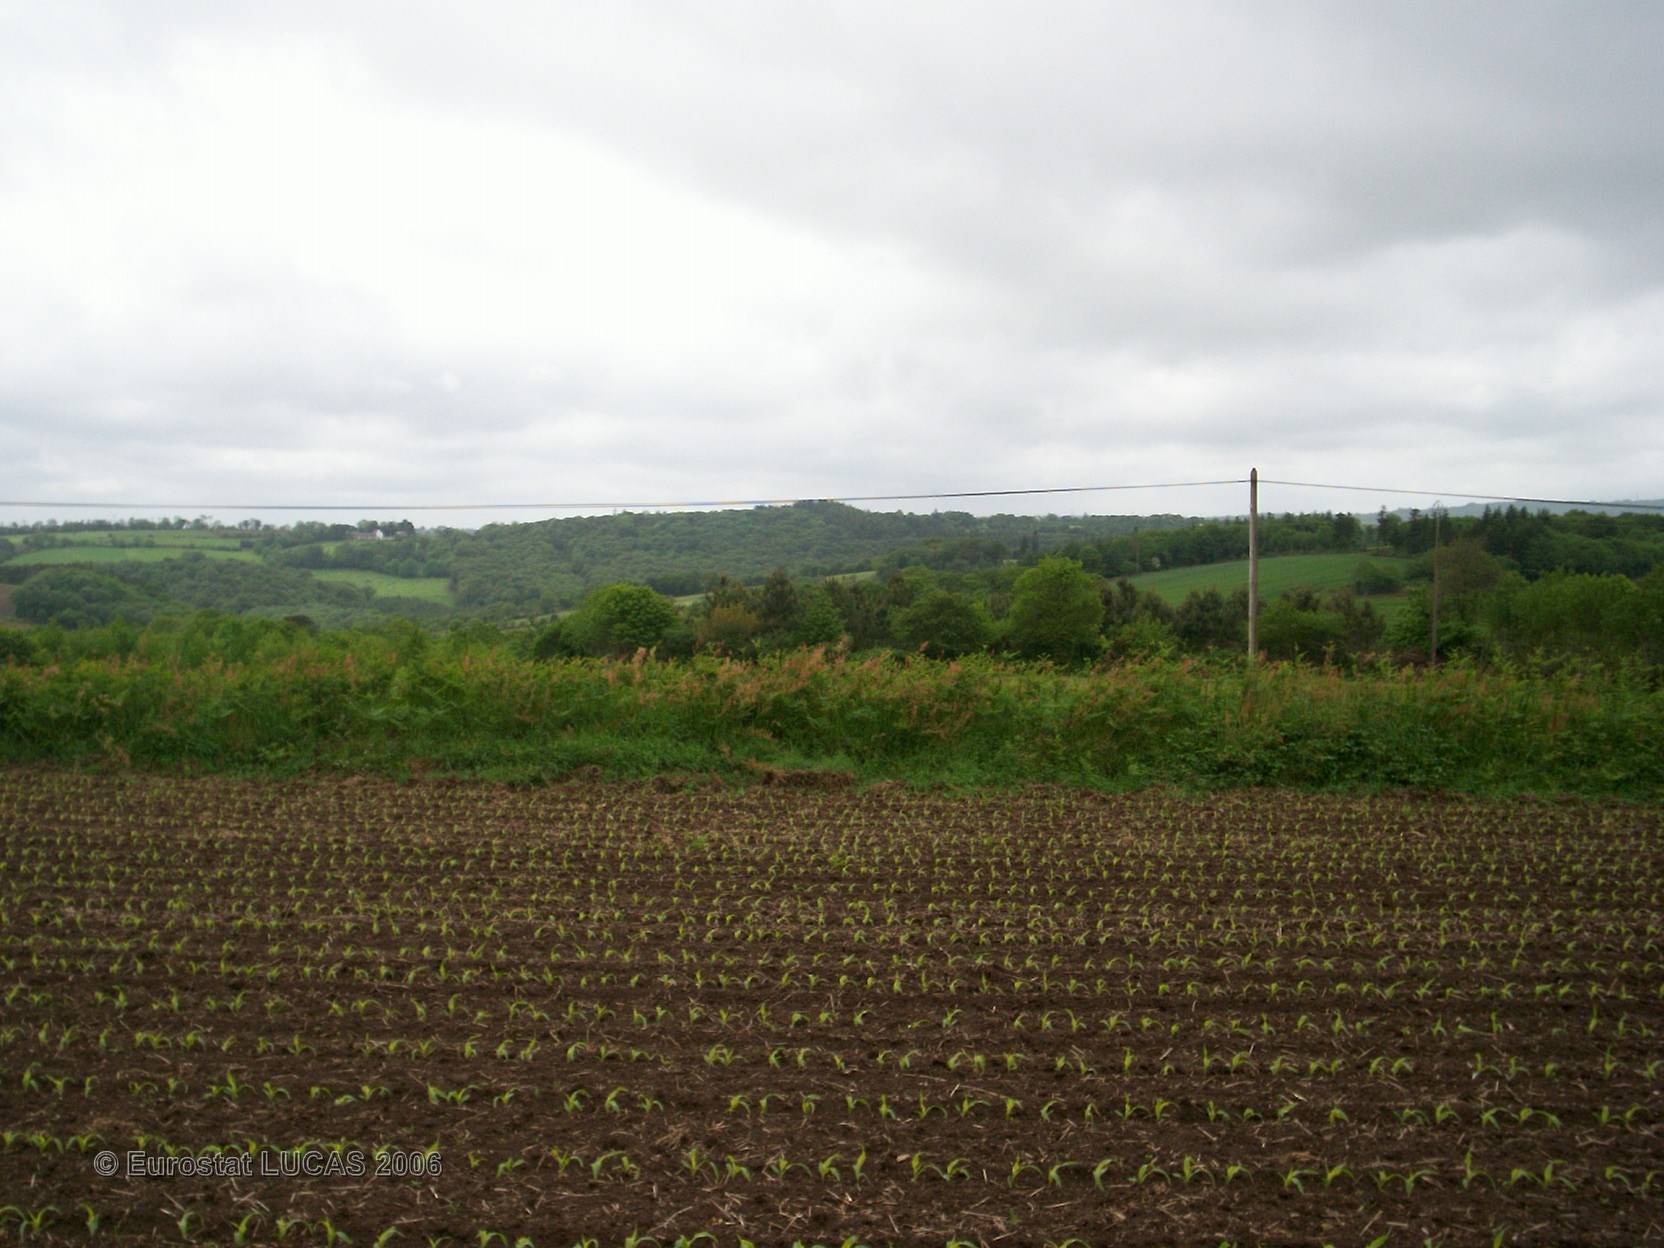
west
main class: Cropland
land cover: Maize
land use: Agriculture (excluding fallow land and kitchen gardens)
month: May
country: FR
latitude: 47.9752
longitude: -3.6223
